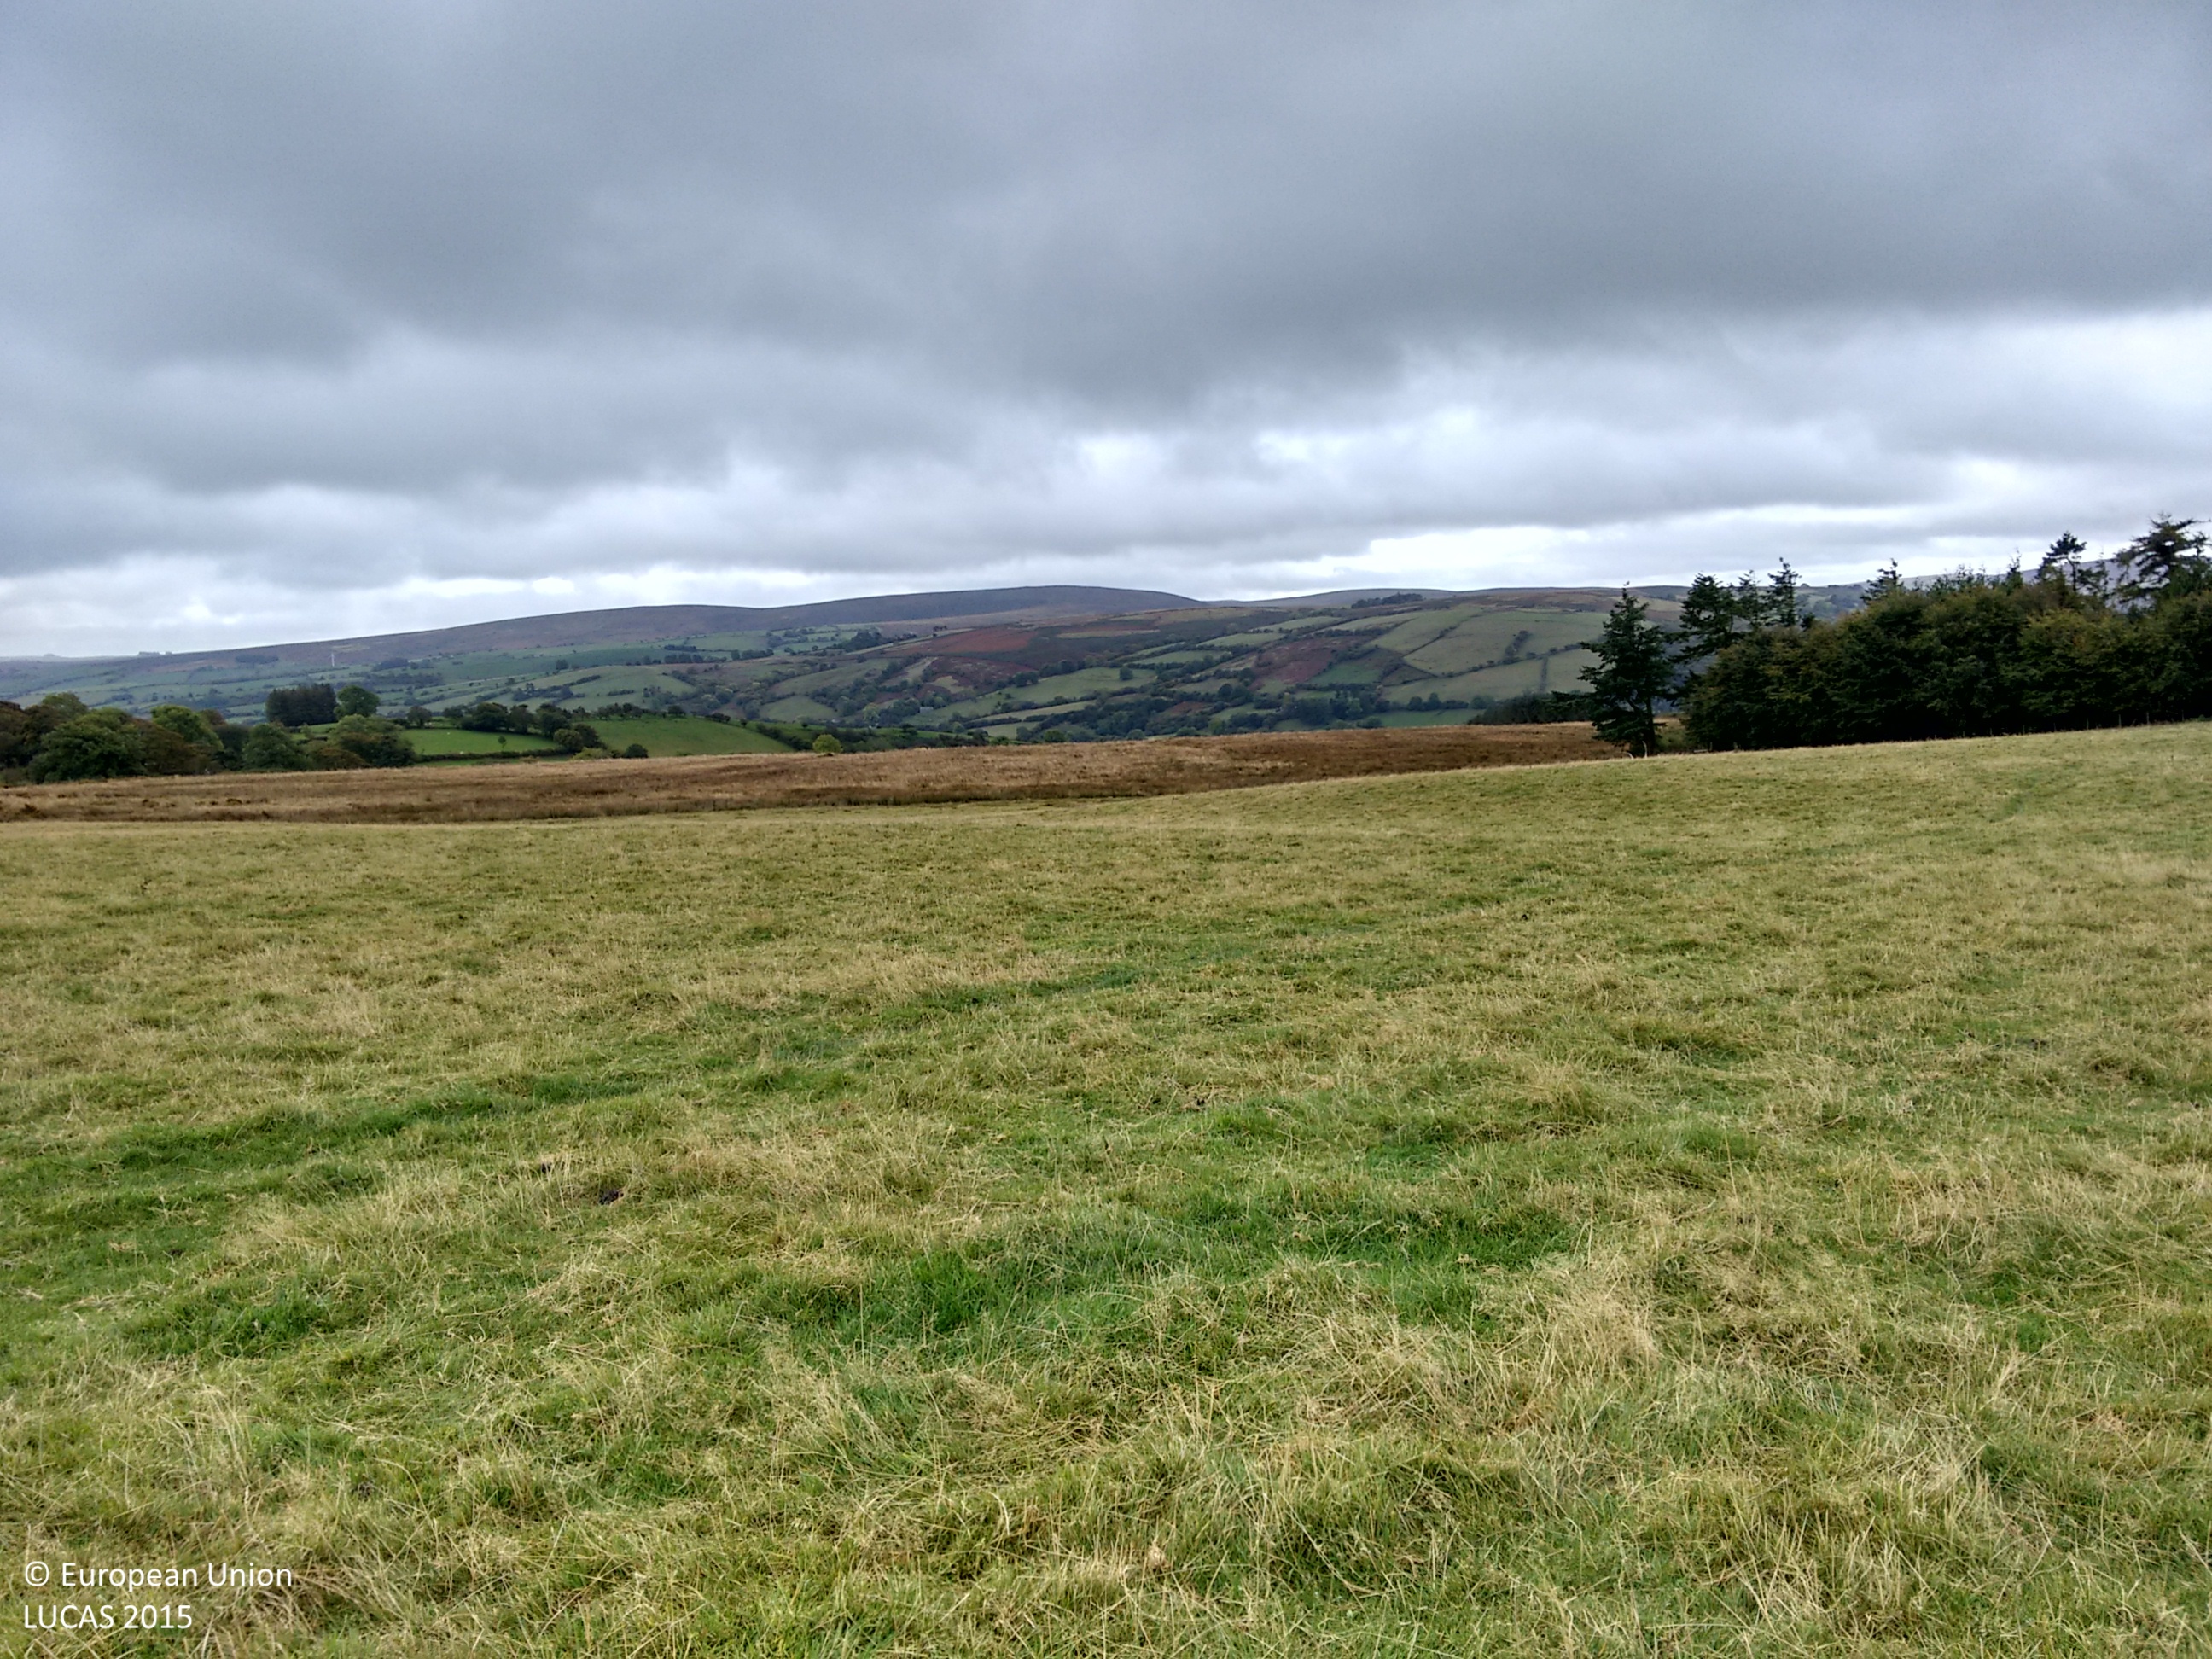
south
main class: Grassland
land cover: Grassland without tree/shrub cover
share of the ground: > 75 %
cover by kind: herbaceous plants 100 %
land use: Agriculture (excluding fallow land and kitchen gardens)
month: October
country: GB
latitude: 52.4365
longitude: -3.2146
